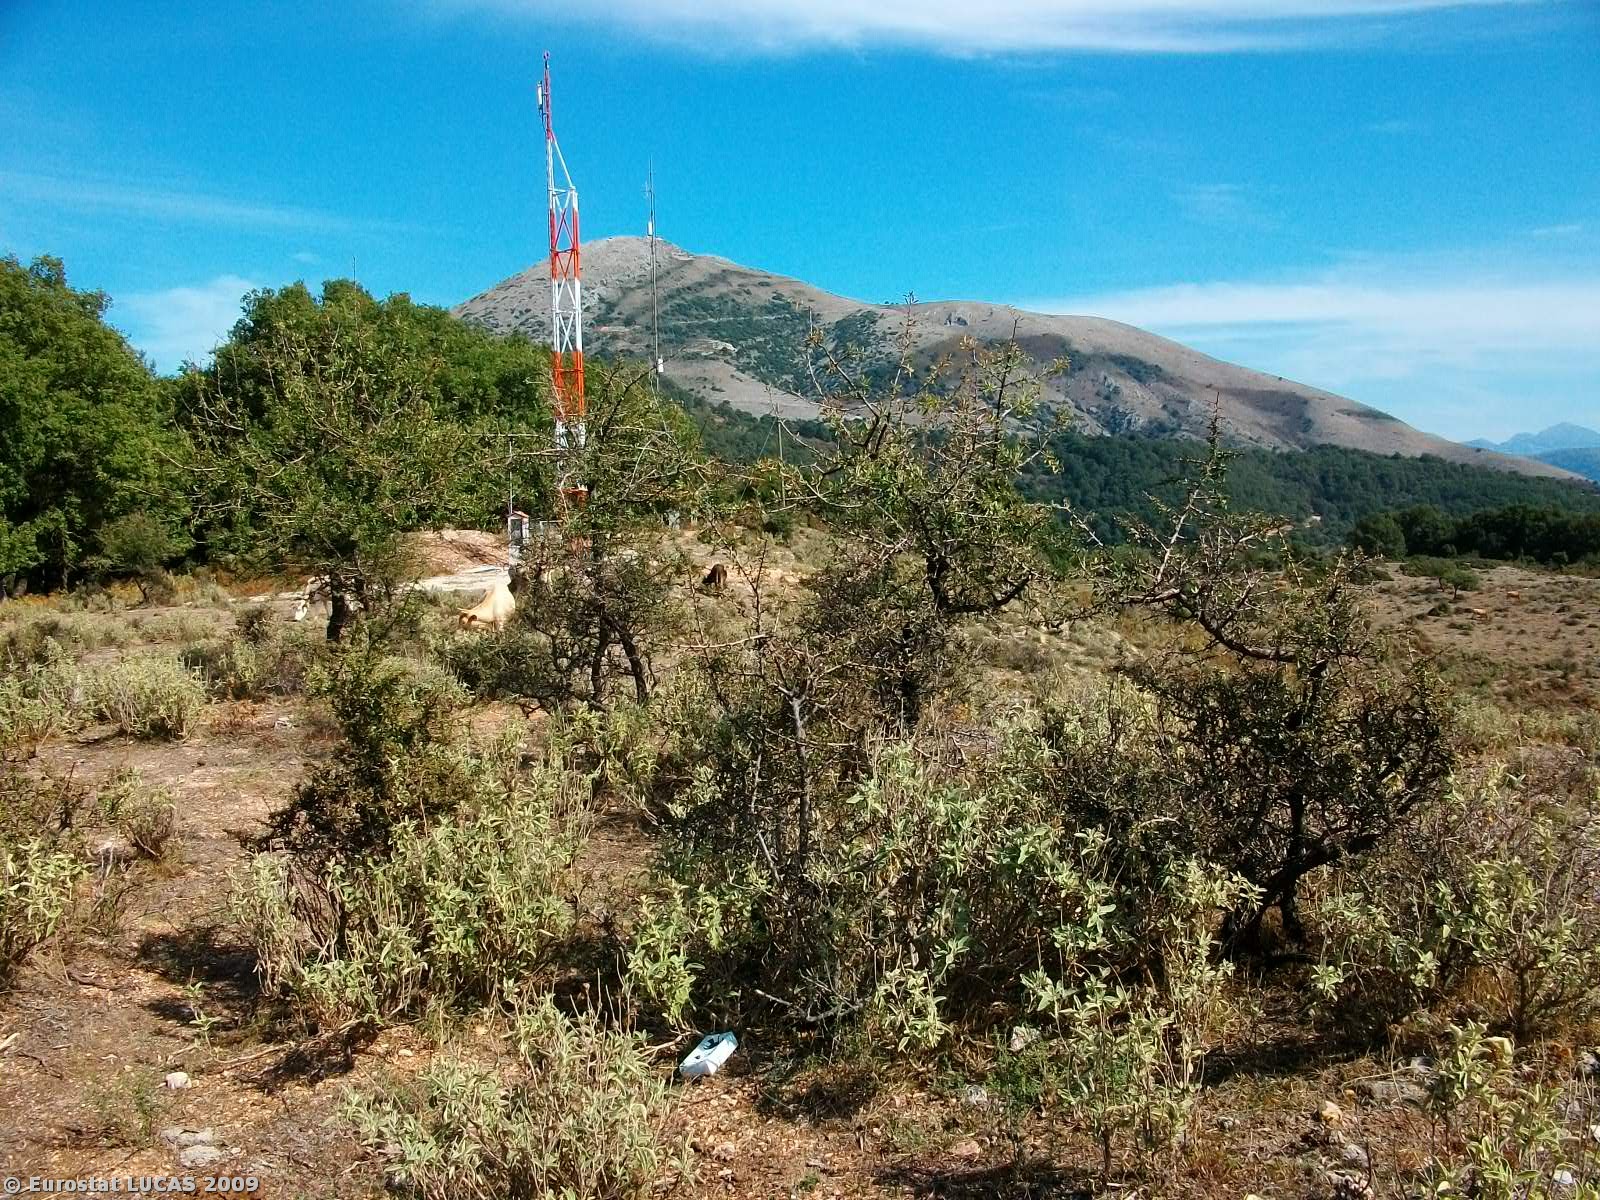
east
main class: Grassland
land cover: Grassland with sparse tree/shrub cover
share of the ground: > 75 %
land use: Agriculture (excluding fallow land and kitchen gardens)
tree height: < 5 m
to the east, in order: Grassland with sparse tree/shrub cover; Electric lines; Grassland with sparse tree/shrub cover; Paved roads, cycling and walking lanes; Broadleaved woodland
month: September
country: GR
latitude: 39.6365
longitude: 20.2637
